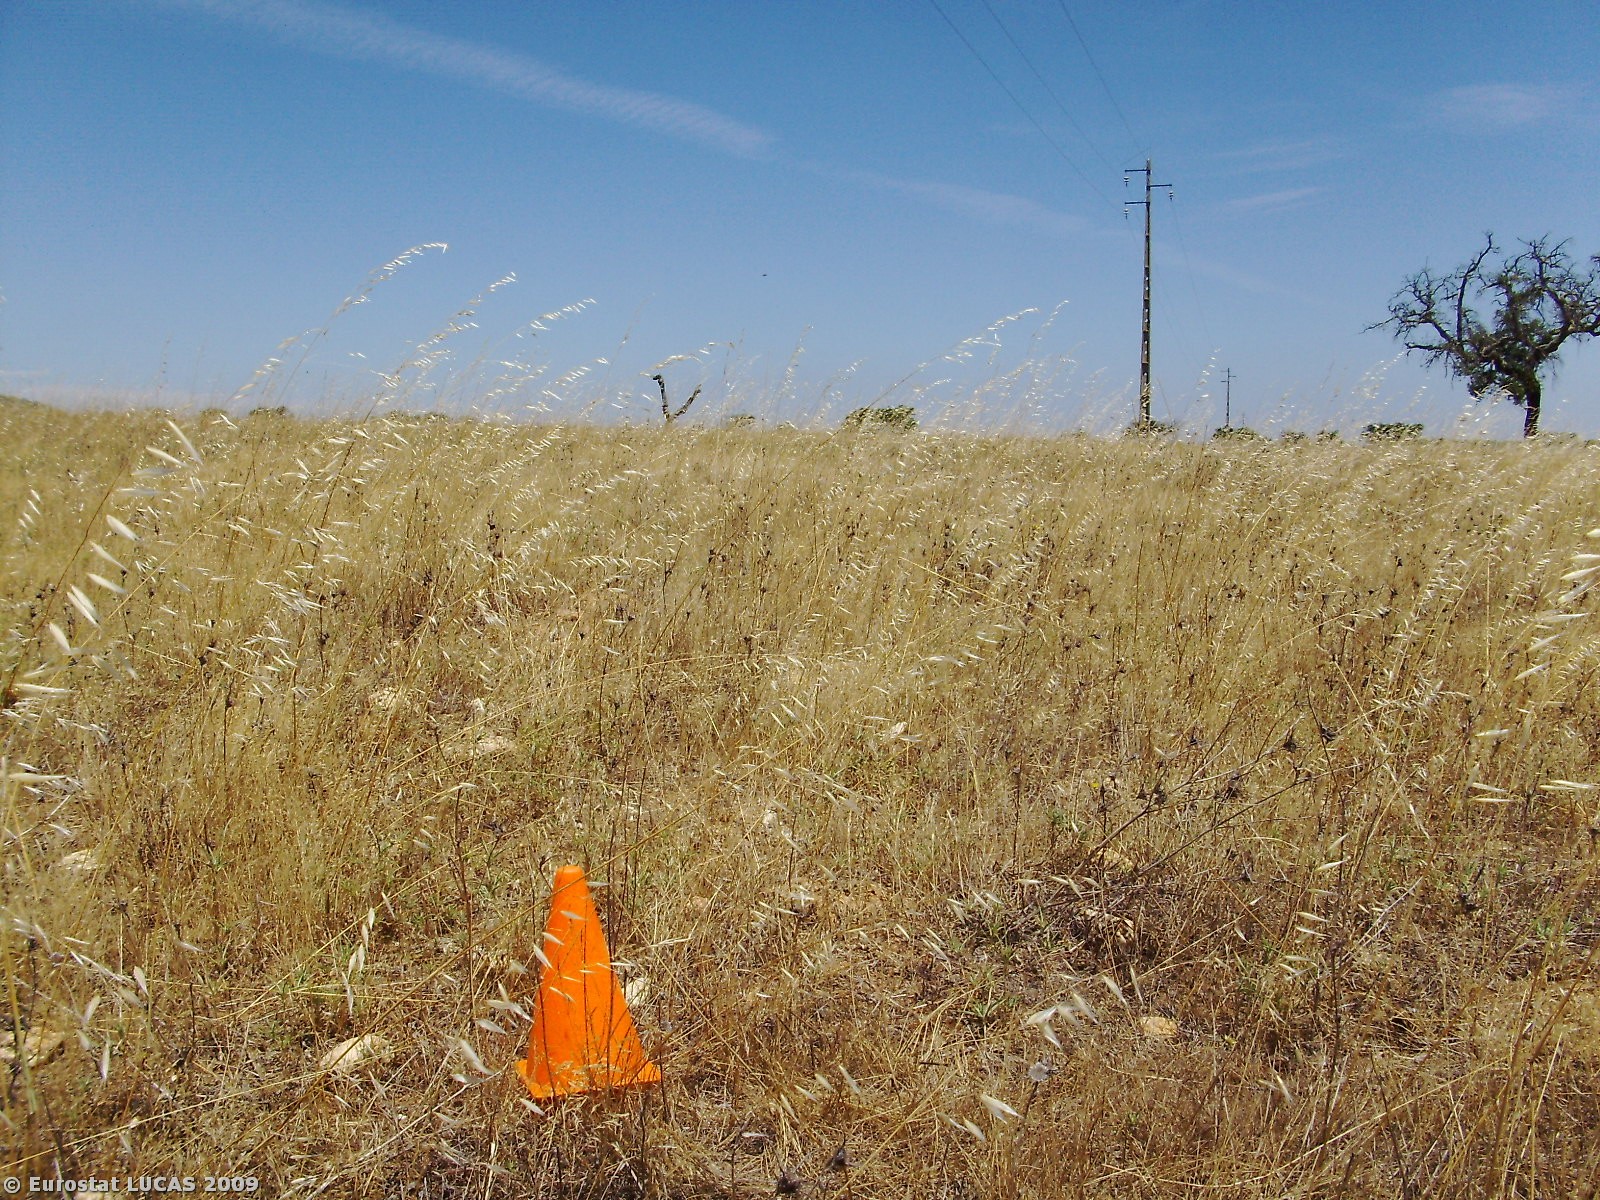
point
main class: Grassland
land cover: Grassland with sparse tree/shrub cover
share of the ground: > 75 %
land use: Agriculture (excluding fallow land and kitchen gardens)
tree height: > 5 m
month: July
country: PT
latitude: 37.7535
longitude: -8.3880
